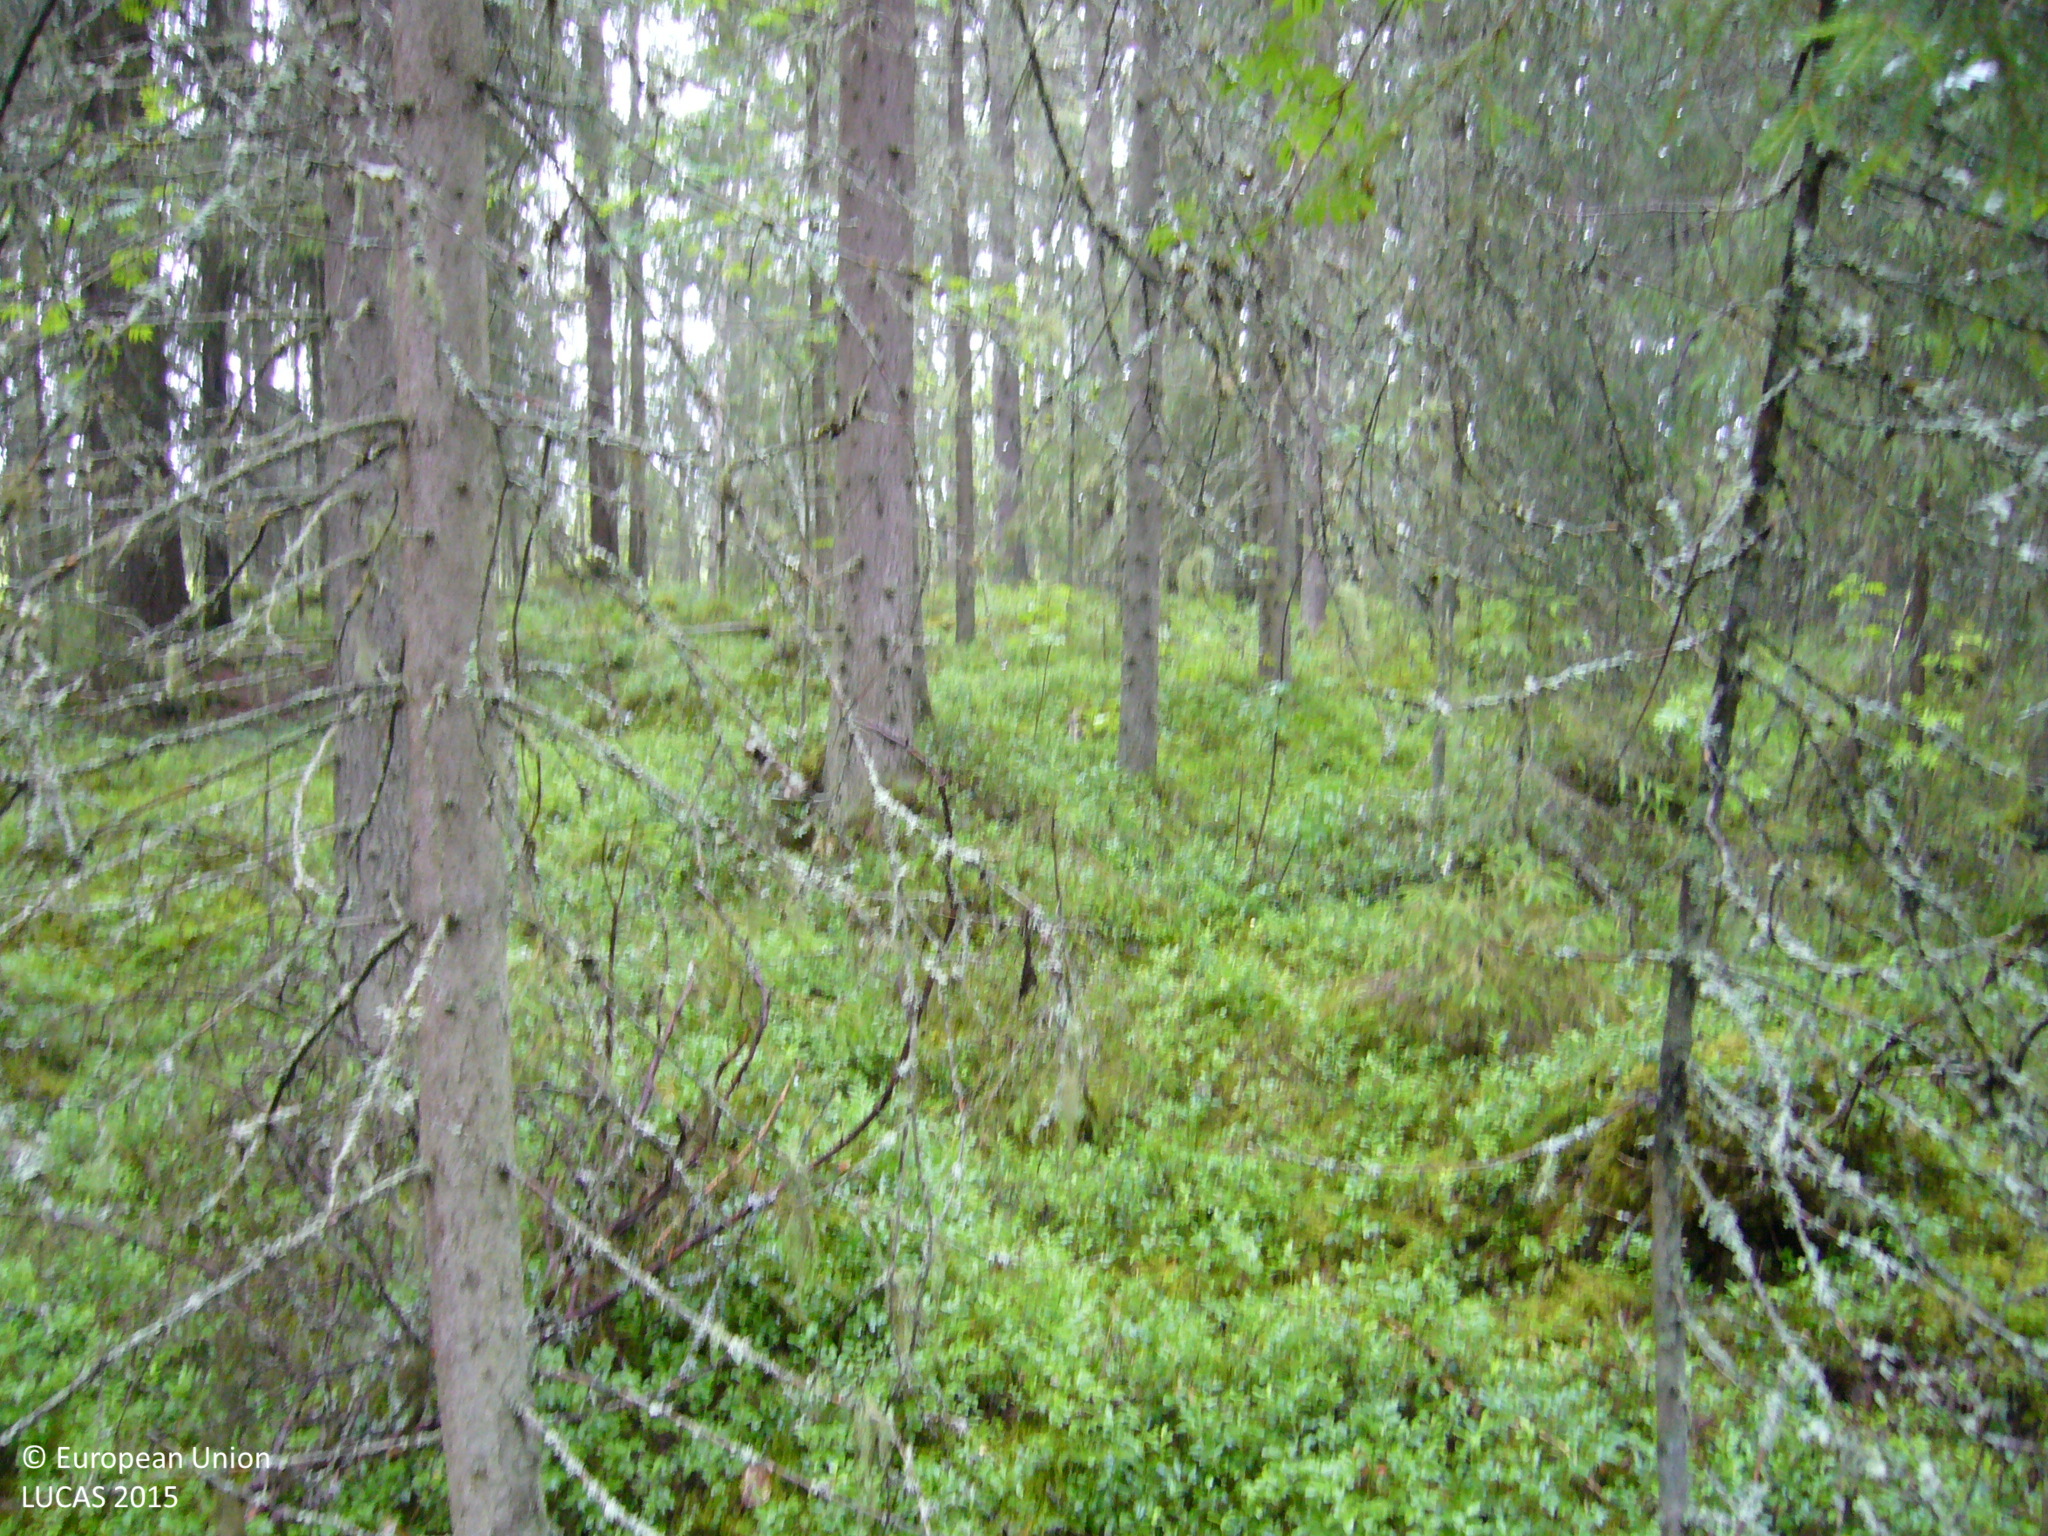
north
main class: Woodland
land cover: Spruce dominated coniferous woodland
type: boreal forest
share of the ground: > 75 %
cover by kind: coniferous forest trees 80 %, shrubs 15 %, broadleaved forest trees 5 %
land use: Forestry
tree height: > 5 m
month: July
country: FI
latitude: 63.9533
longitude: 25.5910
